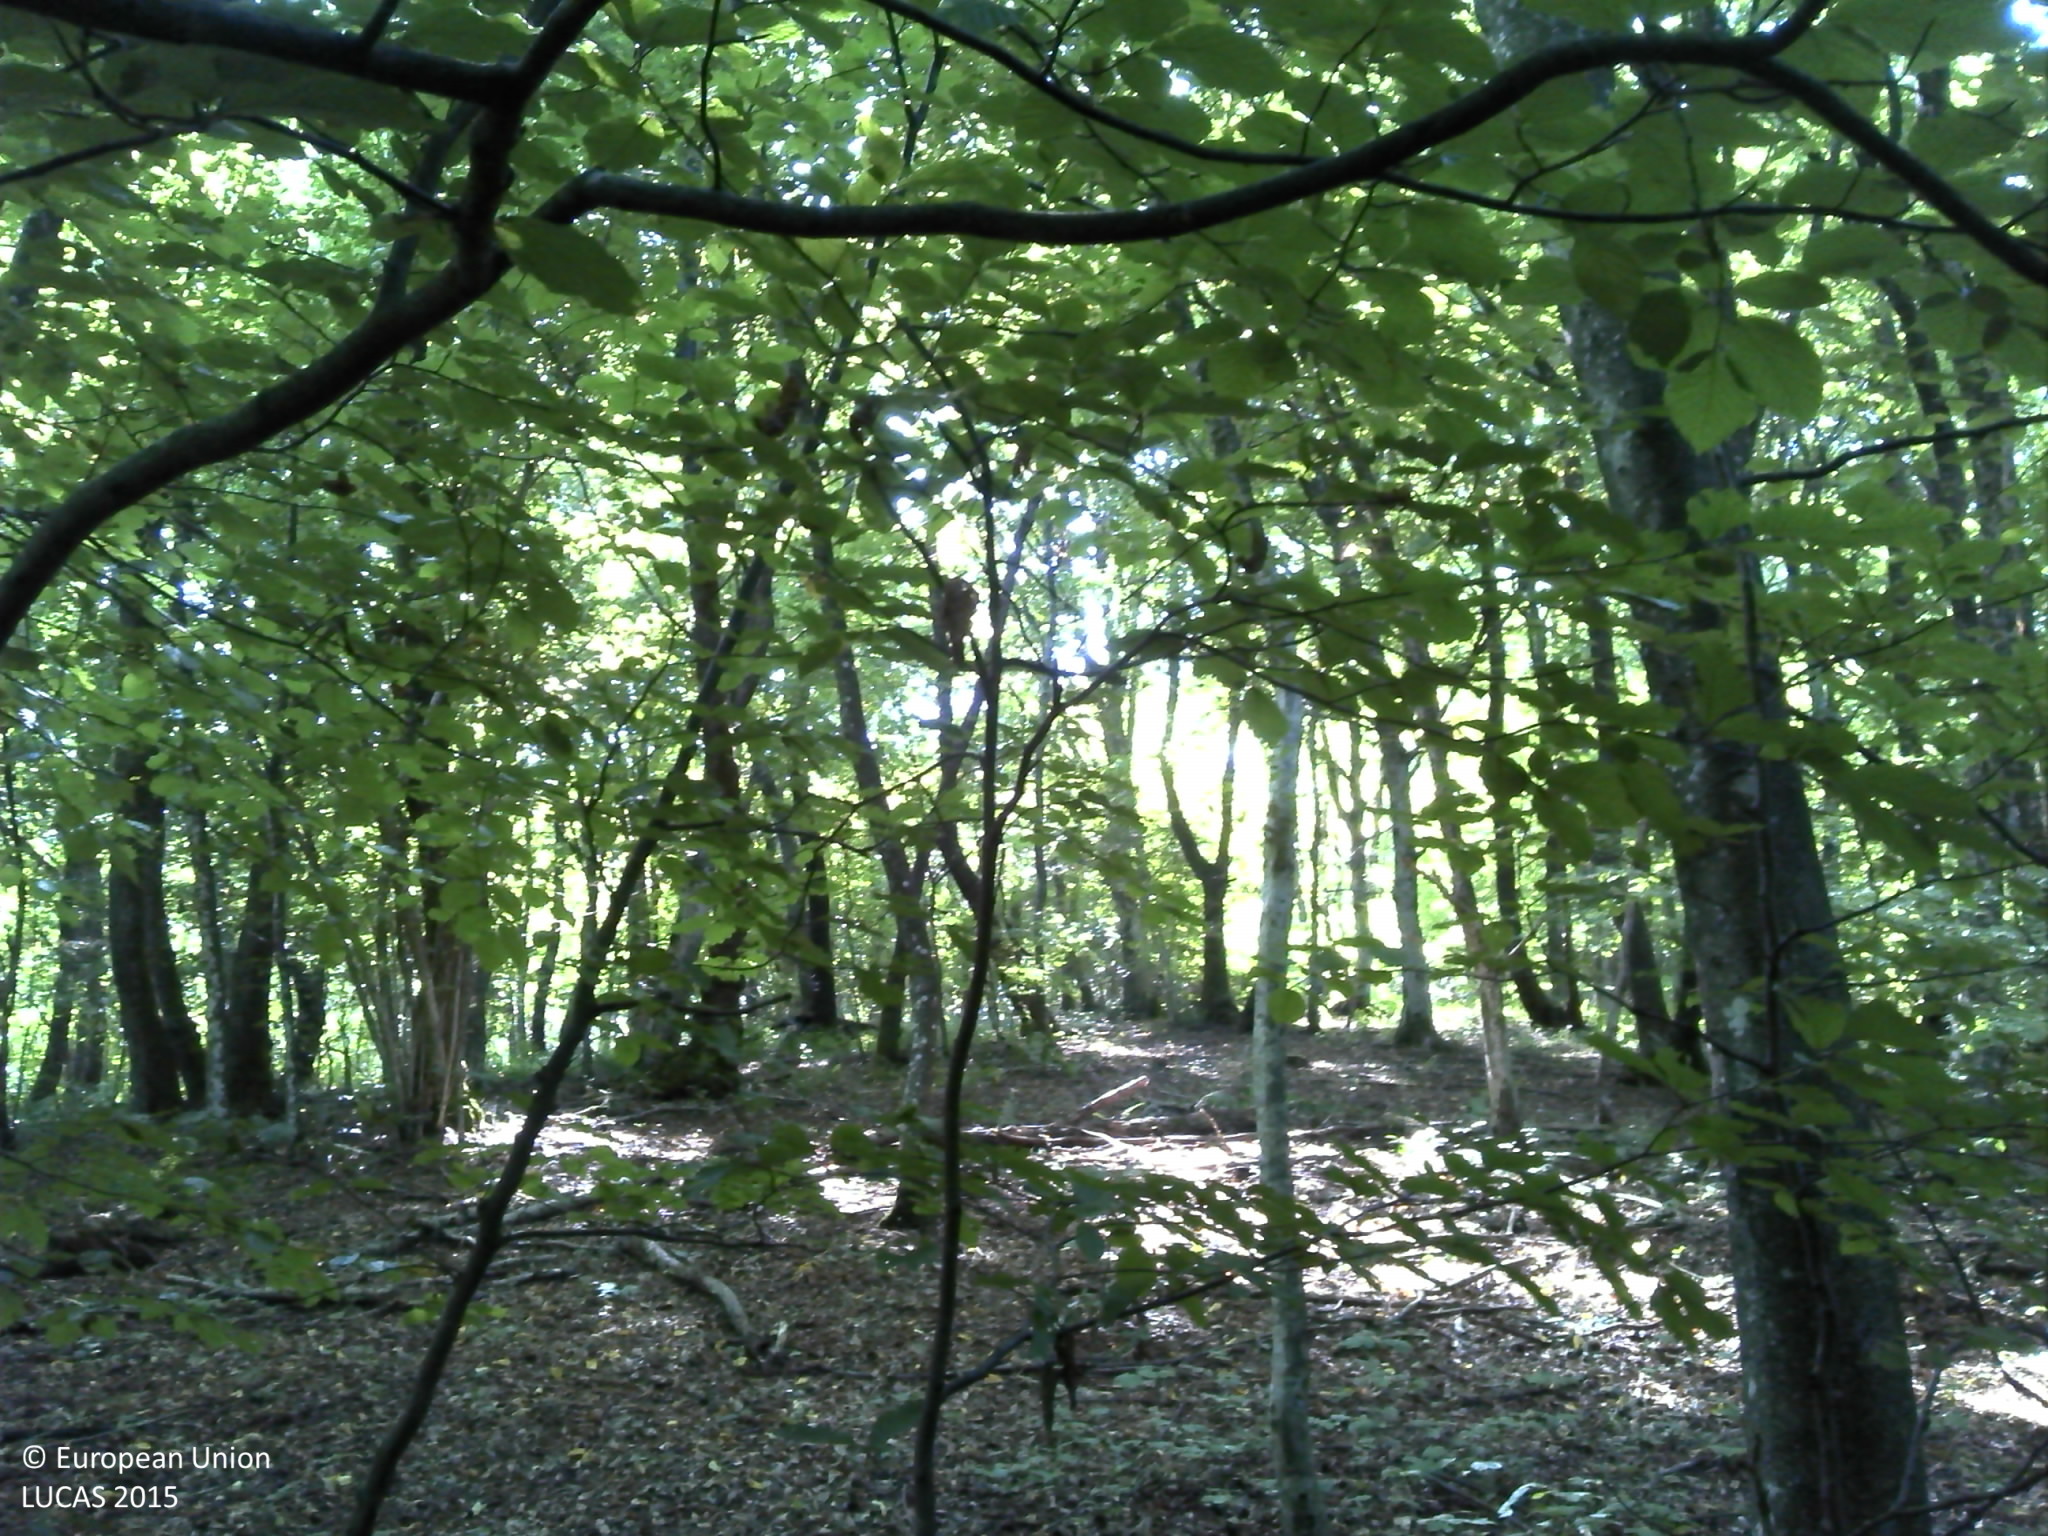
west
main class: Woodland
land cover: Broadleaved woodland
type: beech forest
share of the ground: > 75 %
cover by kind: broadleaved forest trees 100 %
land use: Forestry
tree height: > 5 m
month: August
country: HR
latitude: 45.3144
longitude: 15.6978
